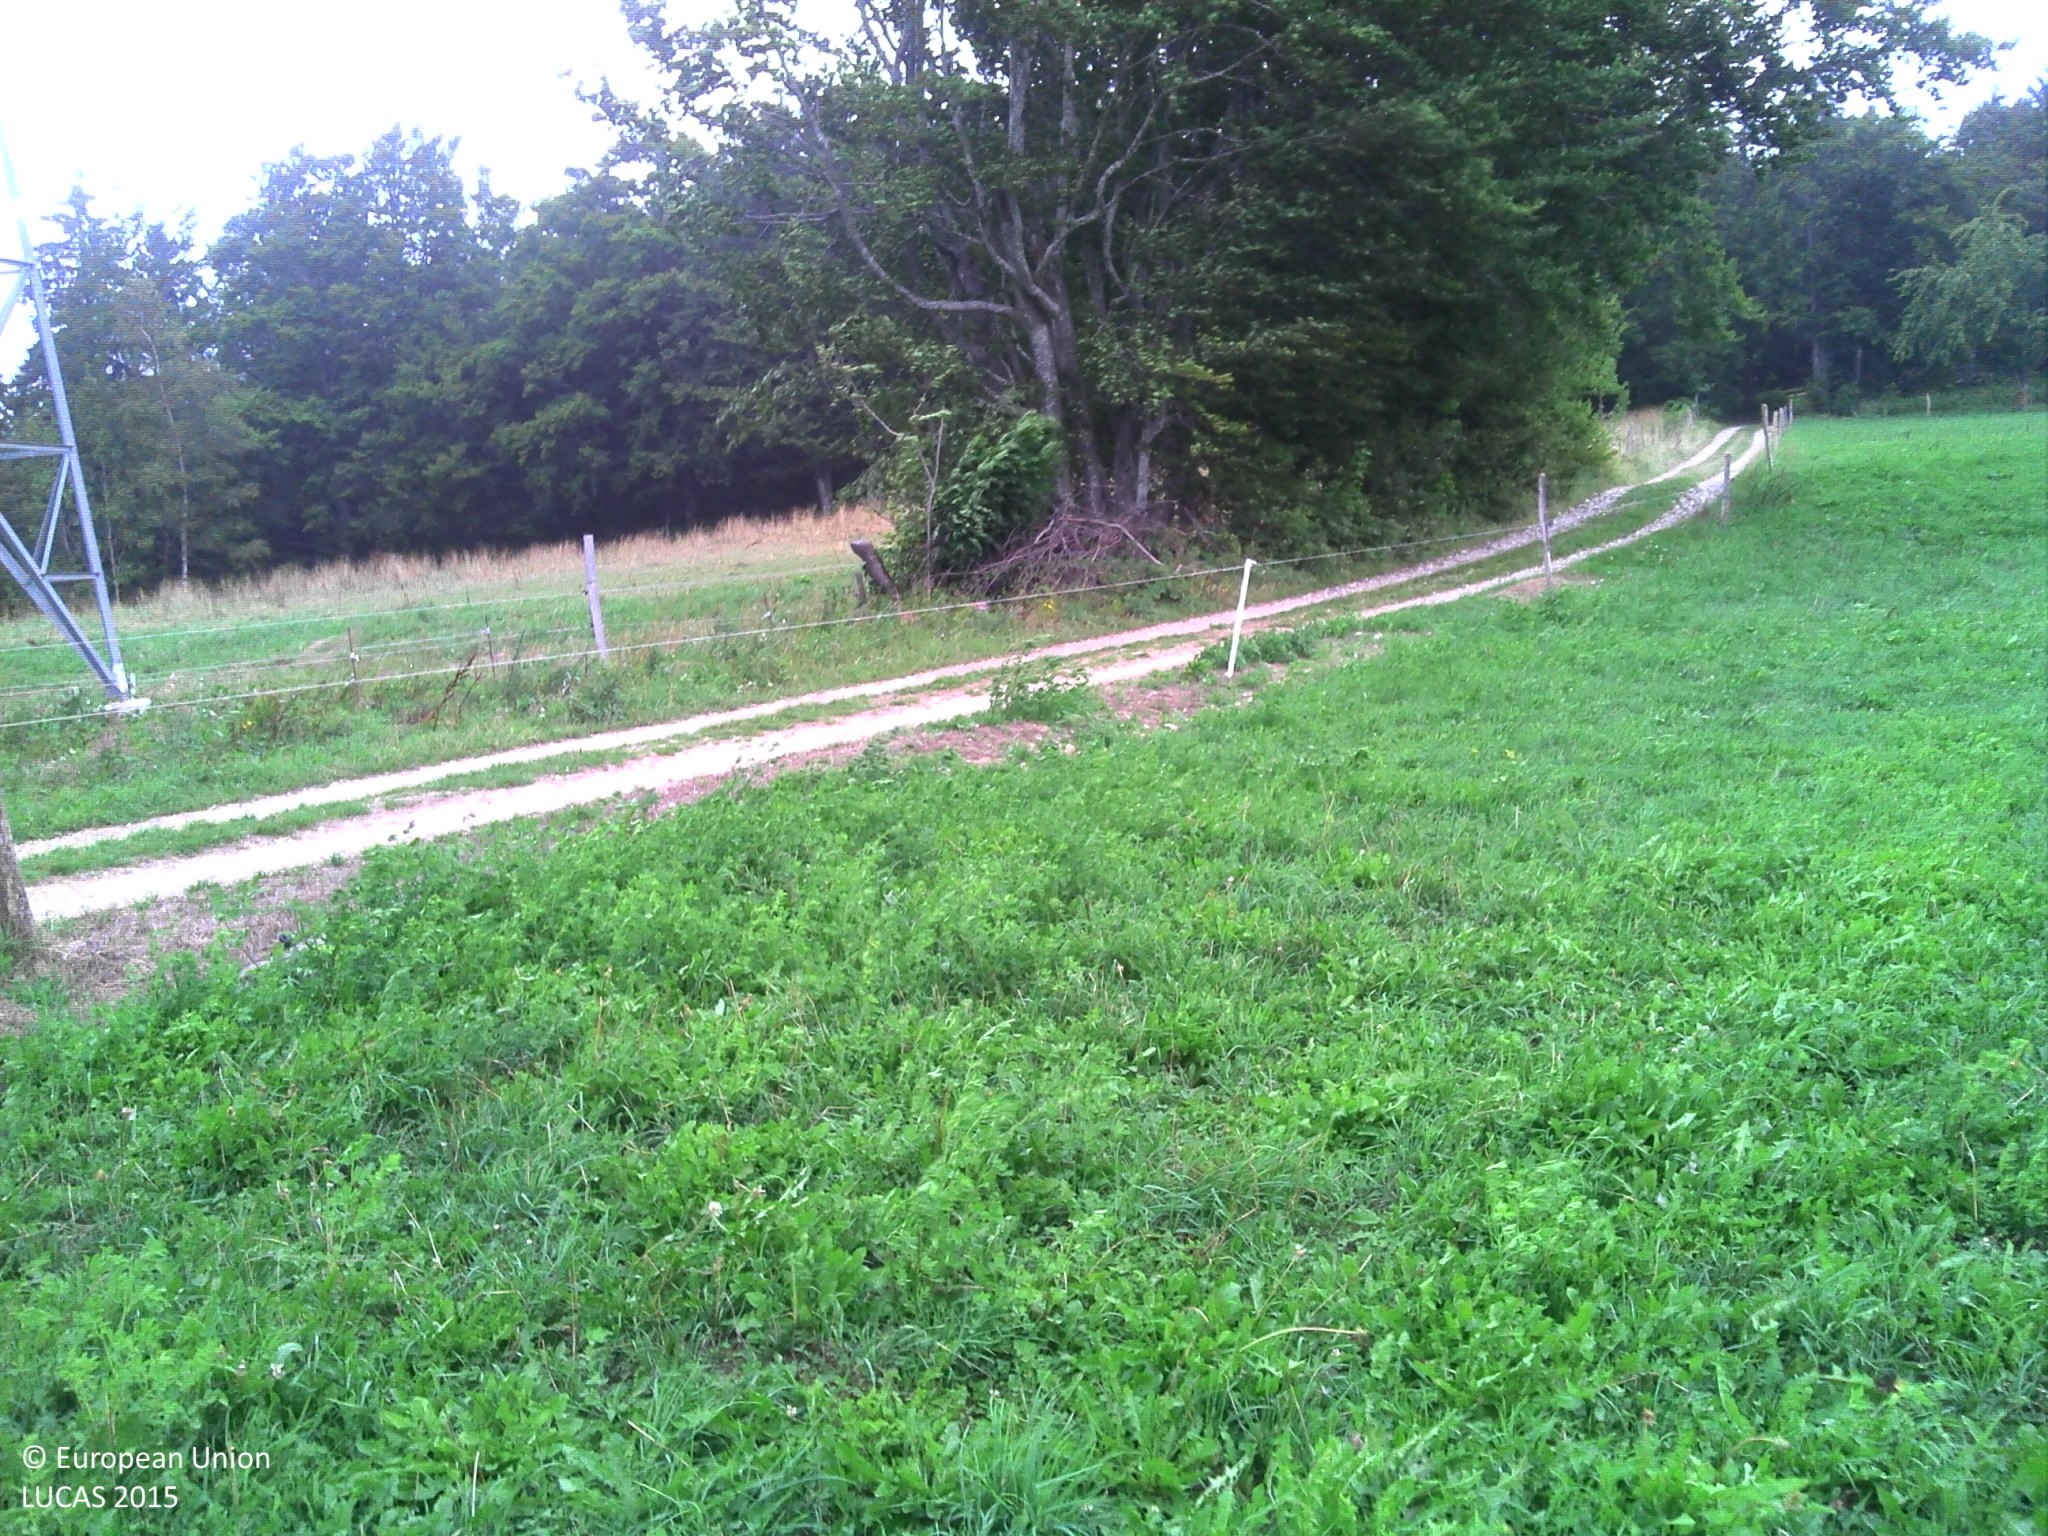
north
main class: Grassland
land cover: Grassland without tree/shrub cover
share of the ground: > 75 %
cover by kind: herbaceous plants 100 %
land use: Agriculture (excluding fallow land and kitchen gardens)
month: August
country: FR
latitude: 45.1798
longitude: 5.6405
